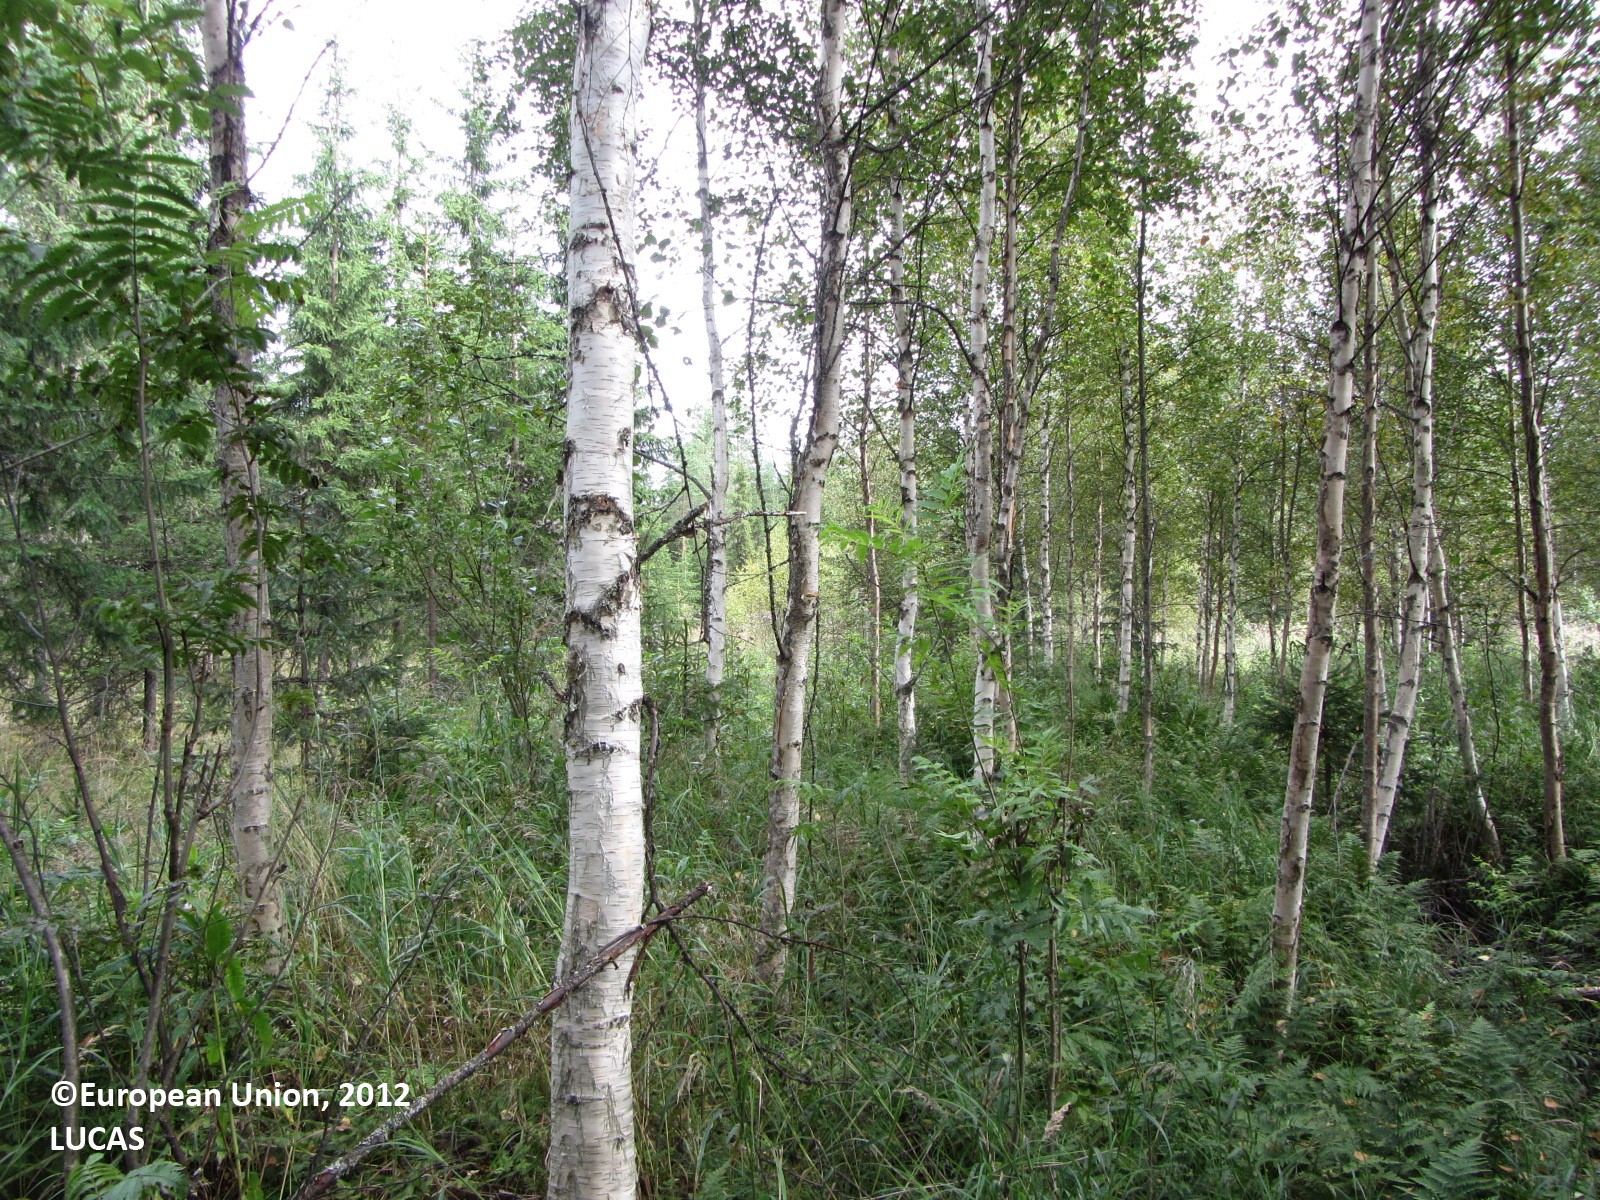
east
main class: Woodland
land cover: Spruce dominated mixed woodland
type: boreal forest
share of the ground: > 75 %
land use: Forestry
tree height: > 5 m
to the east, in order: Spruce dominated mixed woodland; Grassland without tree/shrub cover; Spruce dominated coniferous woodland; Ditches and canals; Spruce dominated coniferous woodland; Other coniferous woodland; Ditches and canals; Spruce dominated coniferous woodland
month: August
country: FI
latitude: 63.2523
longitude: 25.2135
